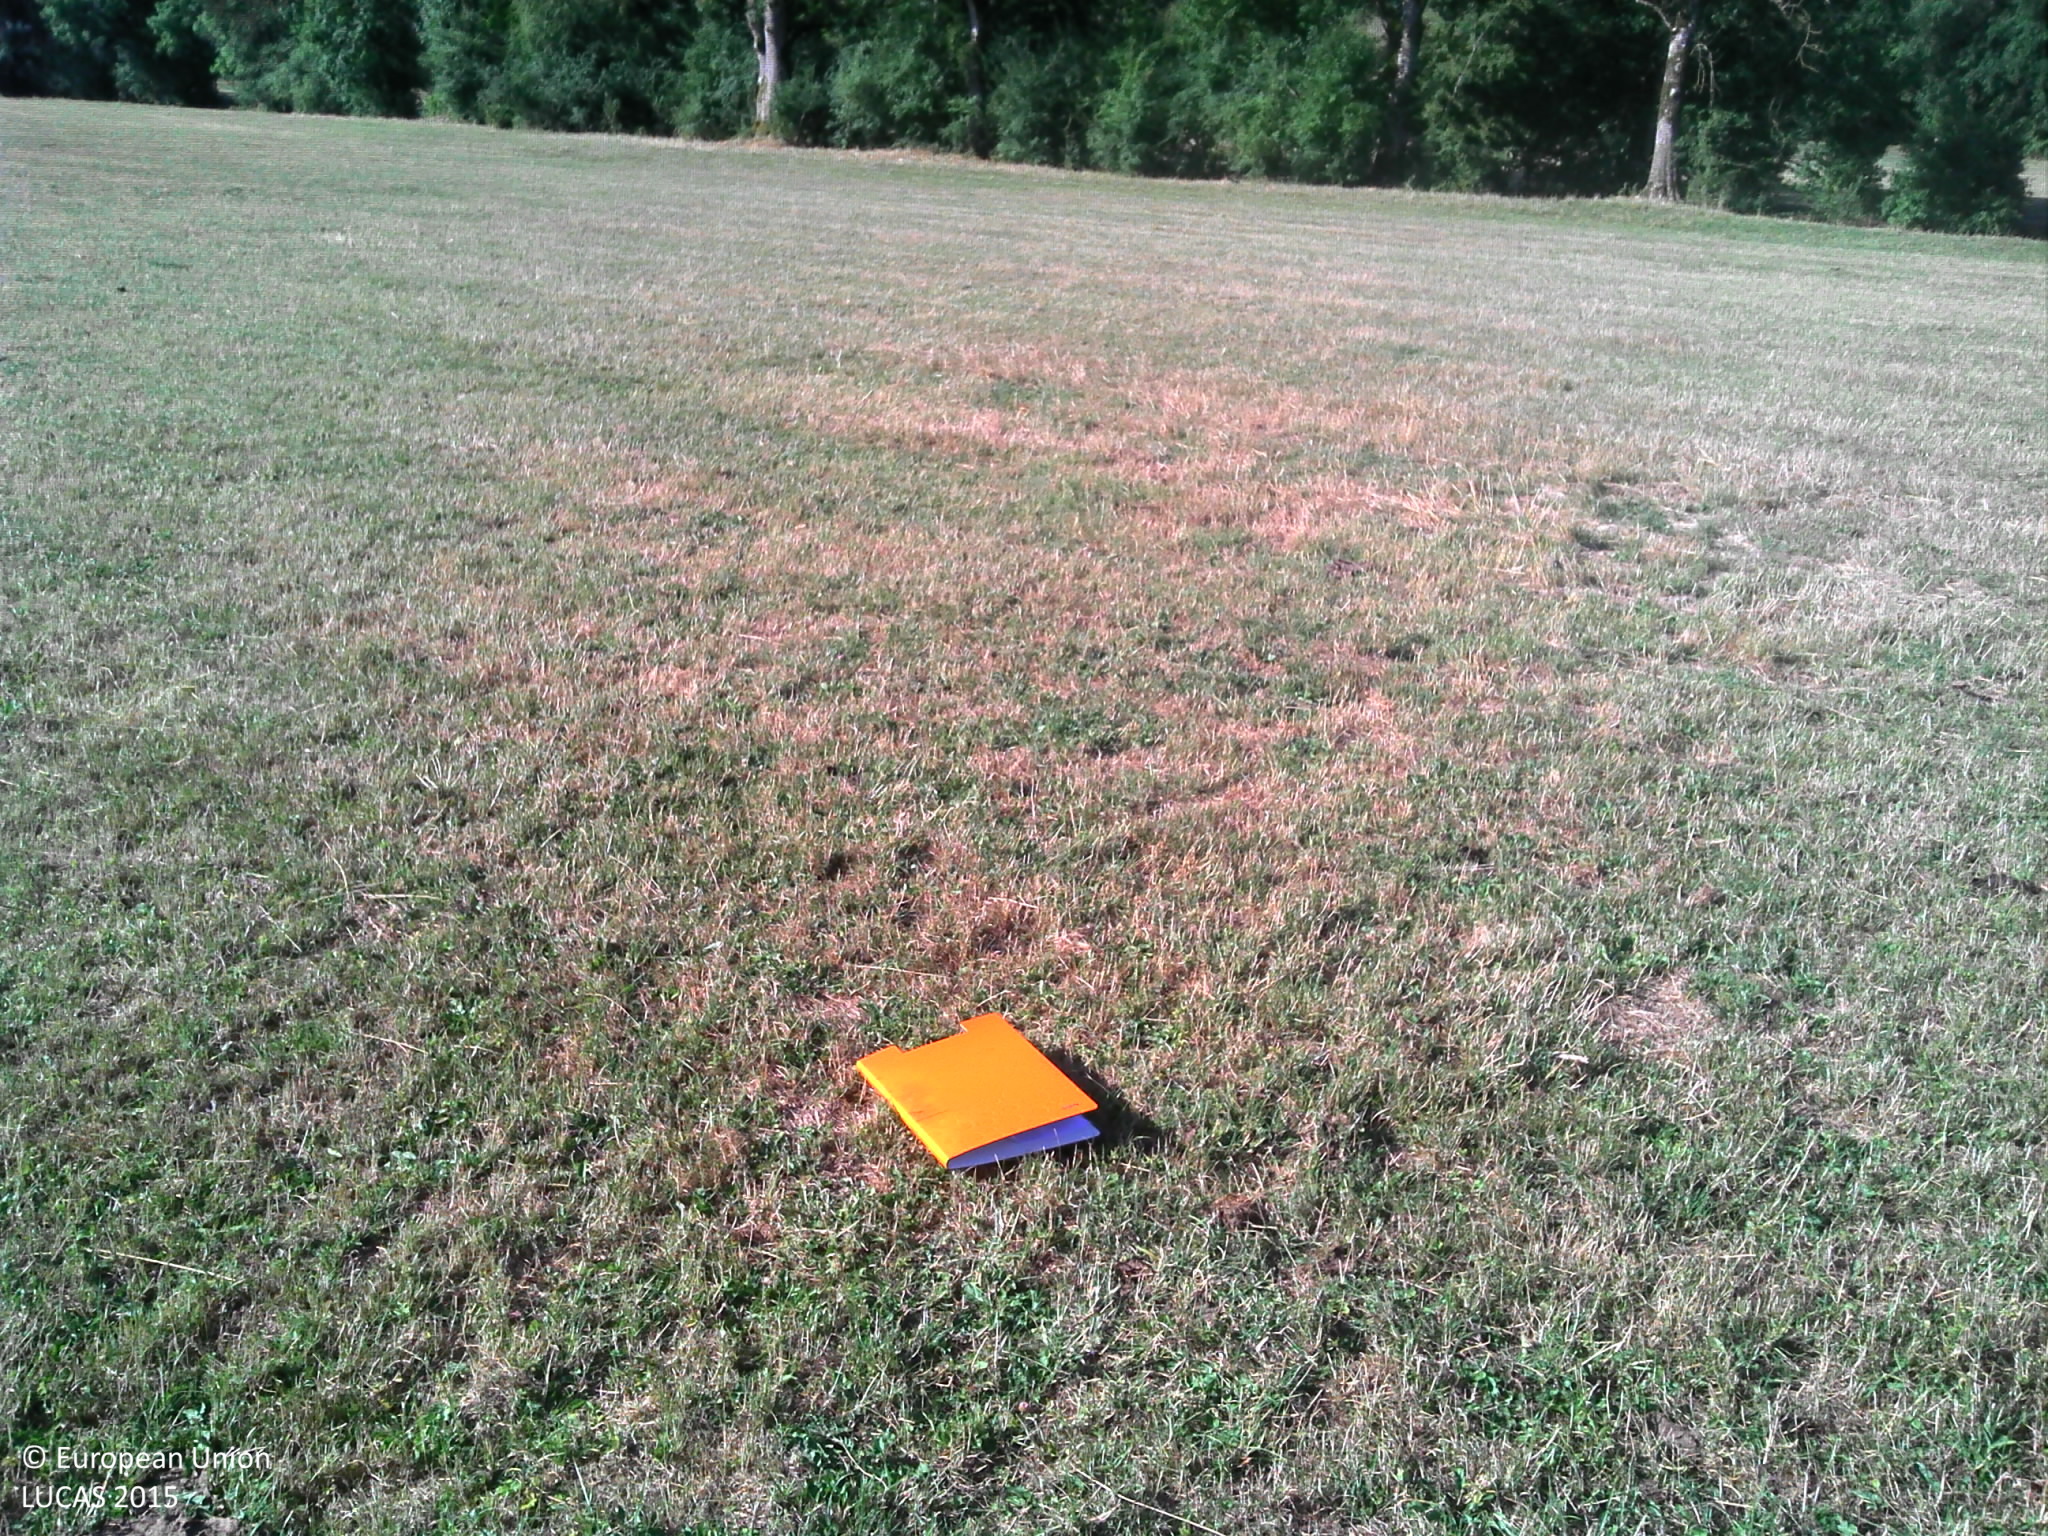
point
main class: Grassland
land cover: Grassland without tree/shrub cover
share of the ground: > 75 %
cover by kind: herbaceous plants 100 %
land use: Agriculture (excluding fallow land and kitchen gardens)
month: July
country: FR
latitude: 47.9146
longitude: 5.0620
